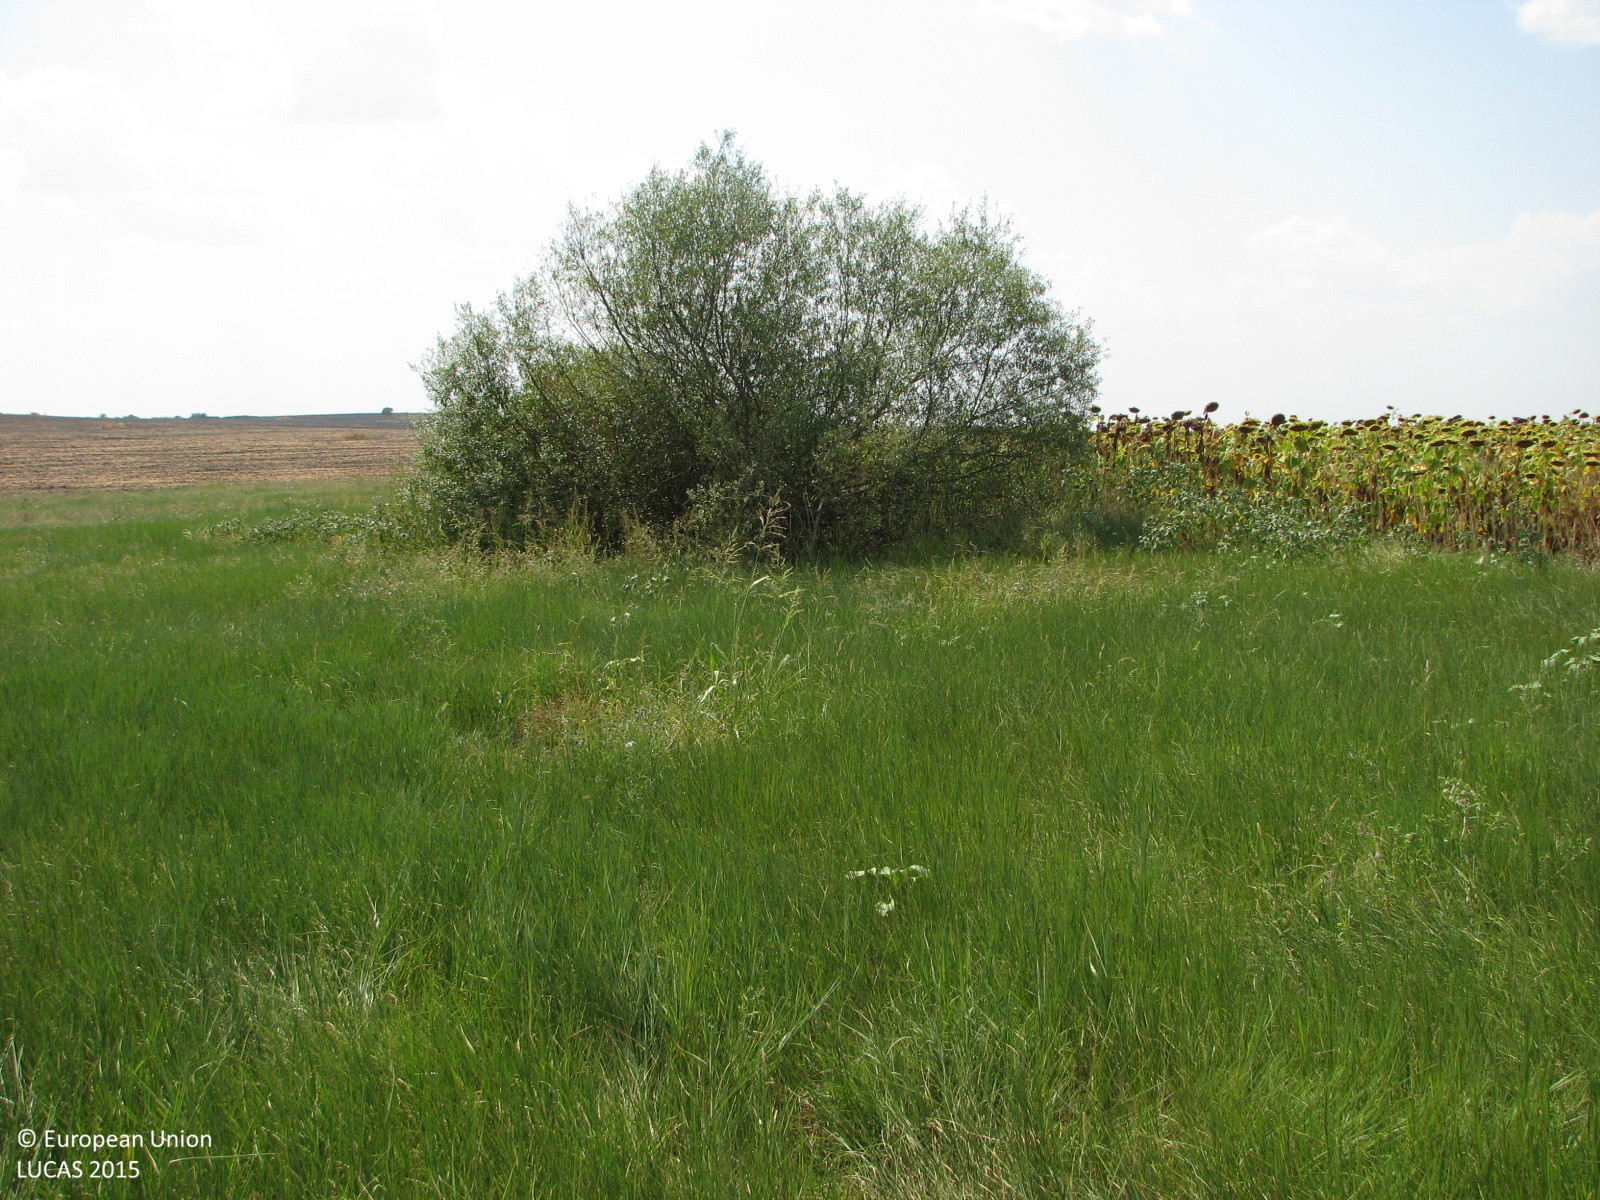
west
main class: Grassland
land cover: Grassland without tree/shrub cover
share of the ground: > 75 %
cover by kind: herbaceous plants 100 %
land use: Agriculture (excluding fallow land and kitchen gardens)
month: August
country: BG
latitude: 42.1482
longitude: 26.7568
